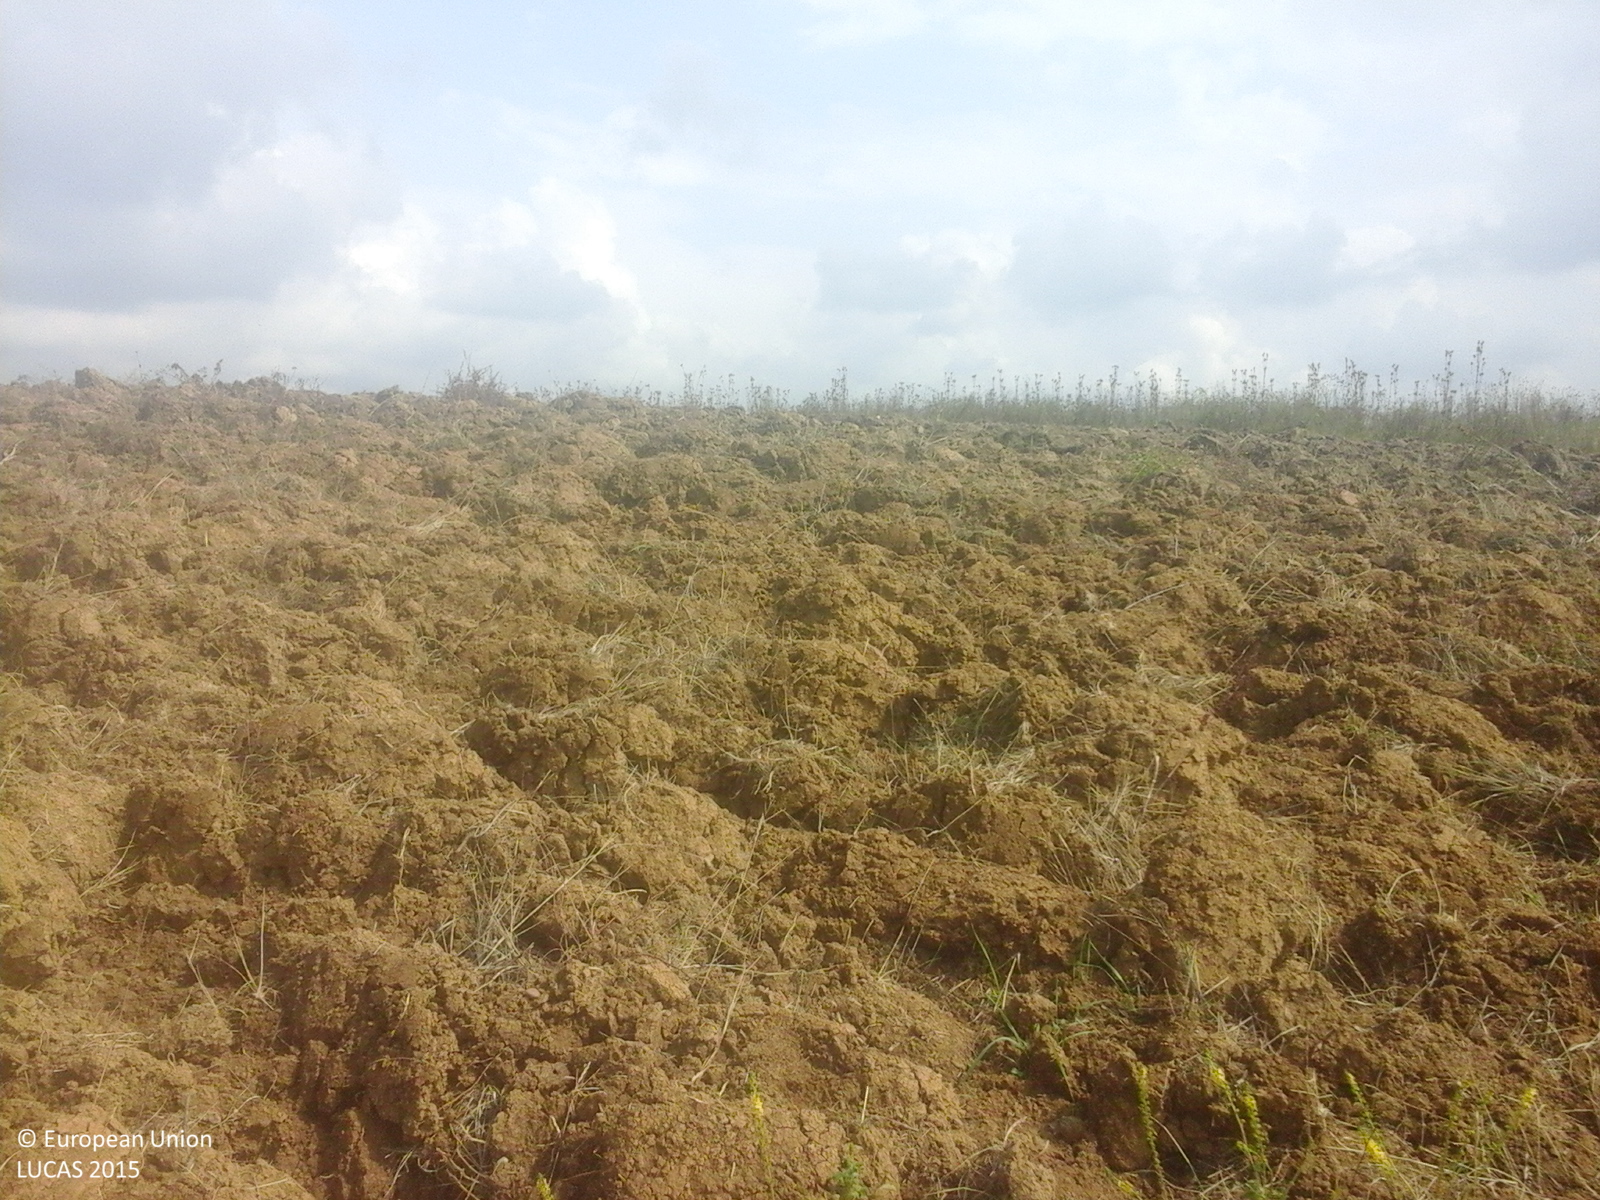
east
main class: Grassland
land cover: Spontaneously vegetated surfaces
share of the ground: > 75 %
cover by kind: herbaceous plants 100 %
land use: Fallow land
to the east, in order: Spontaneously vegetated surfaces; Other bare soil; Lucerne; Grassland without tree/shrub cover; Tracks; Other non-permanent industrial crops
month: September
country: RO
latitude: 46.8444
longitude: 21.9390
